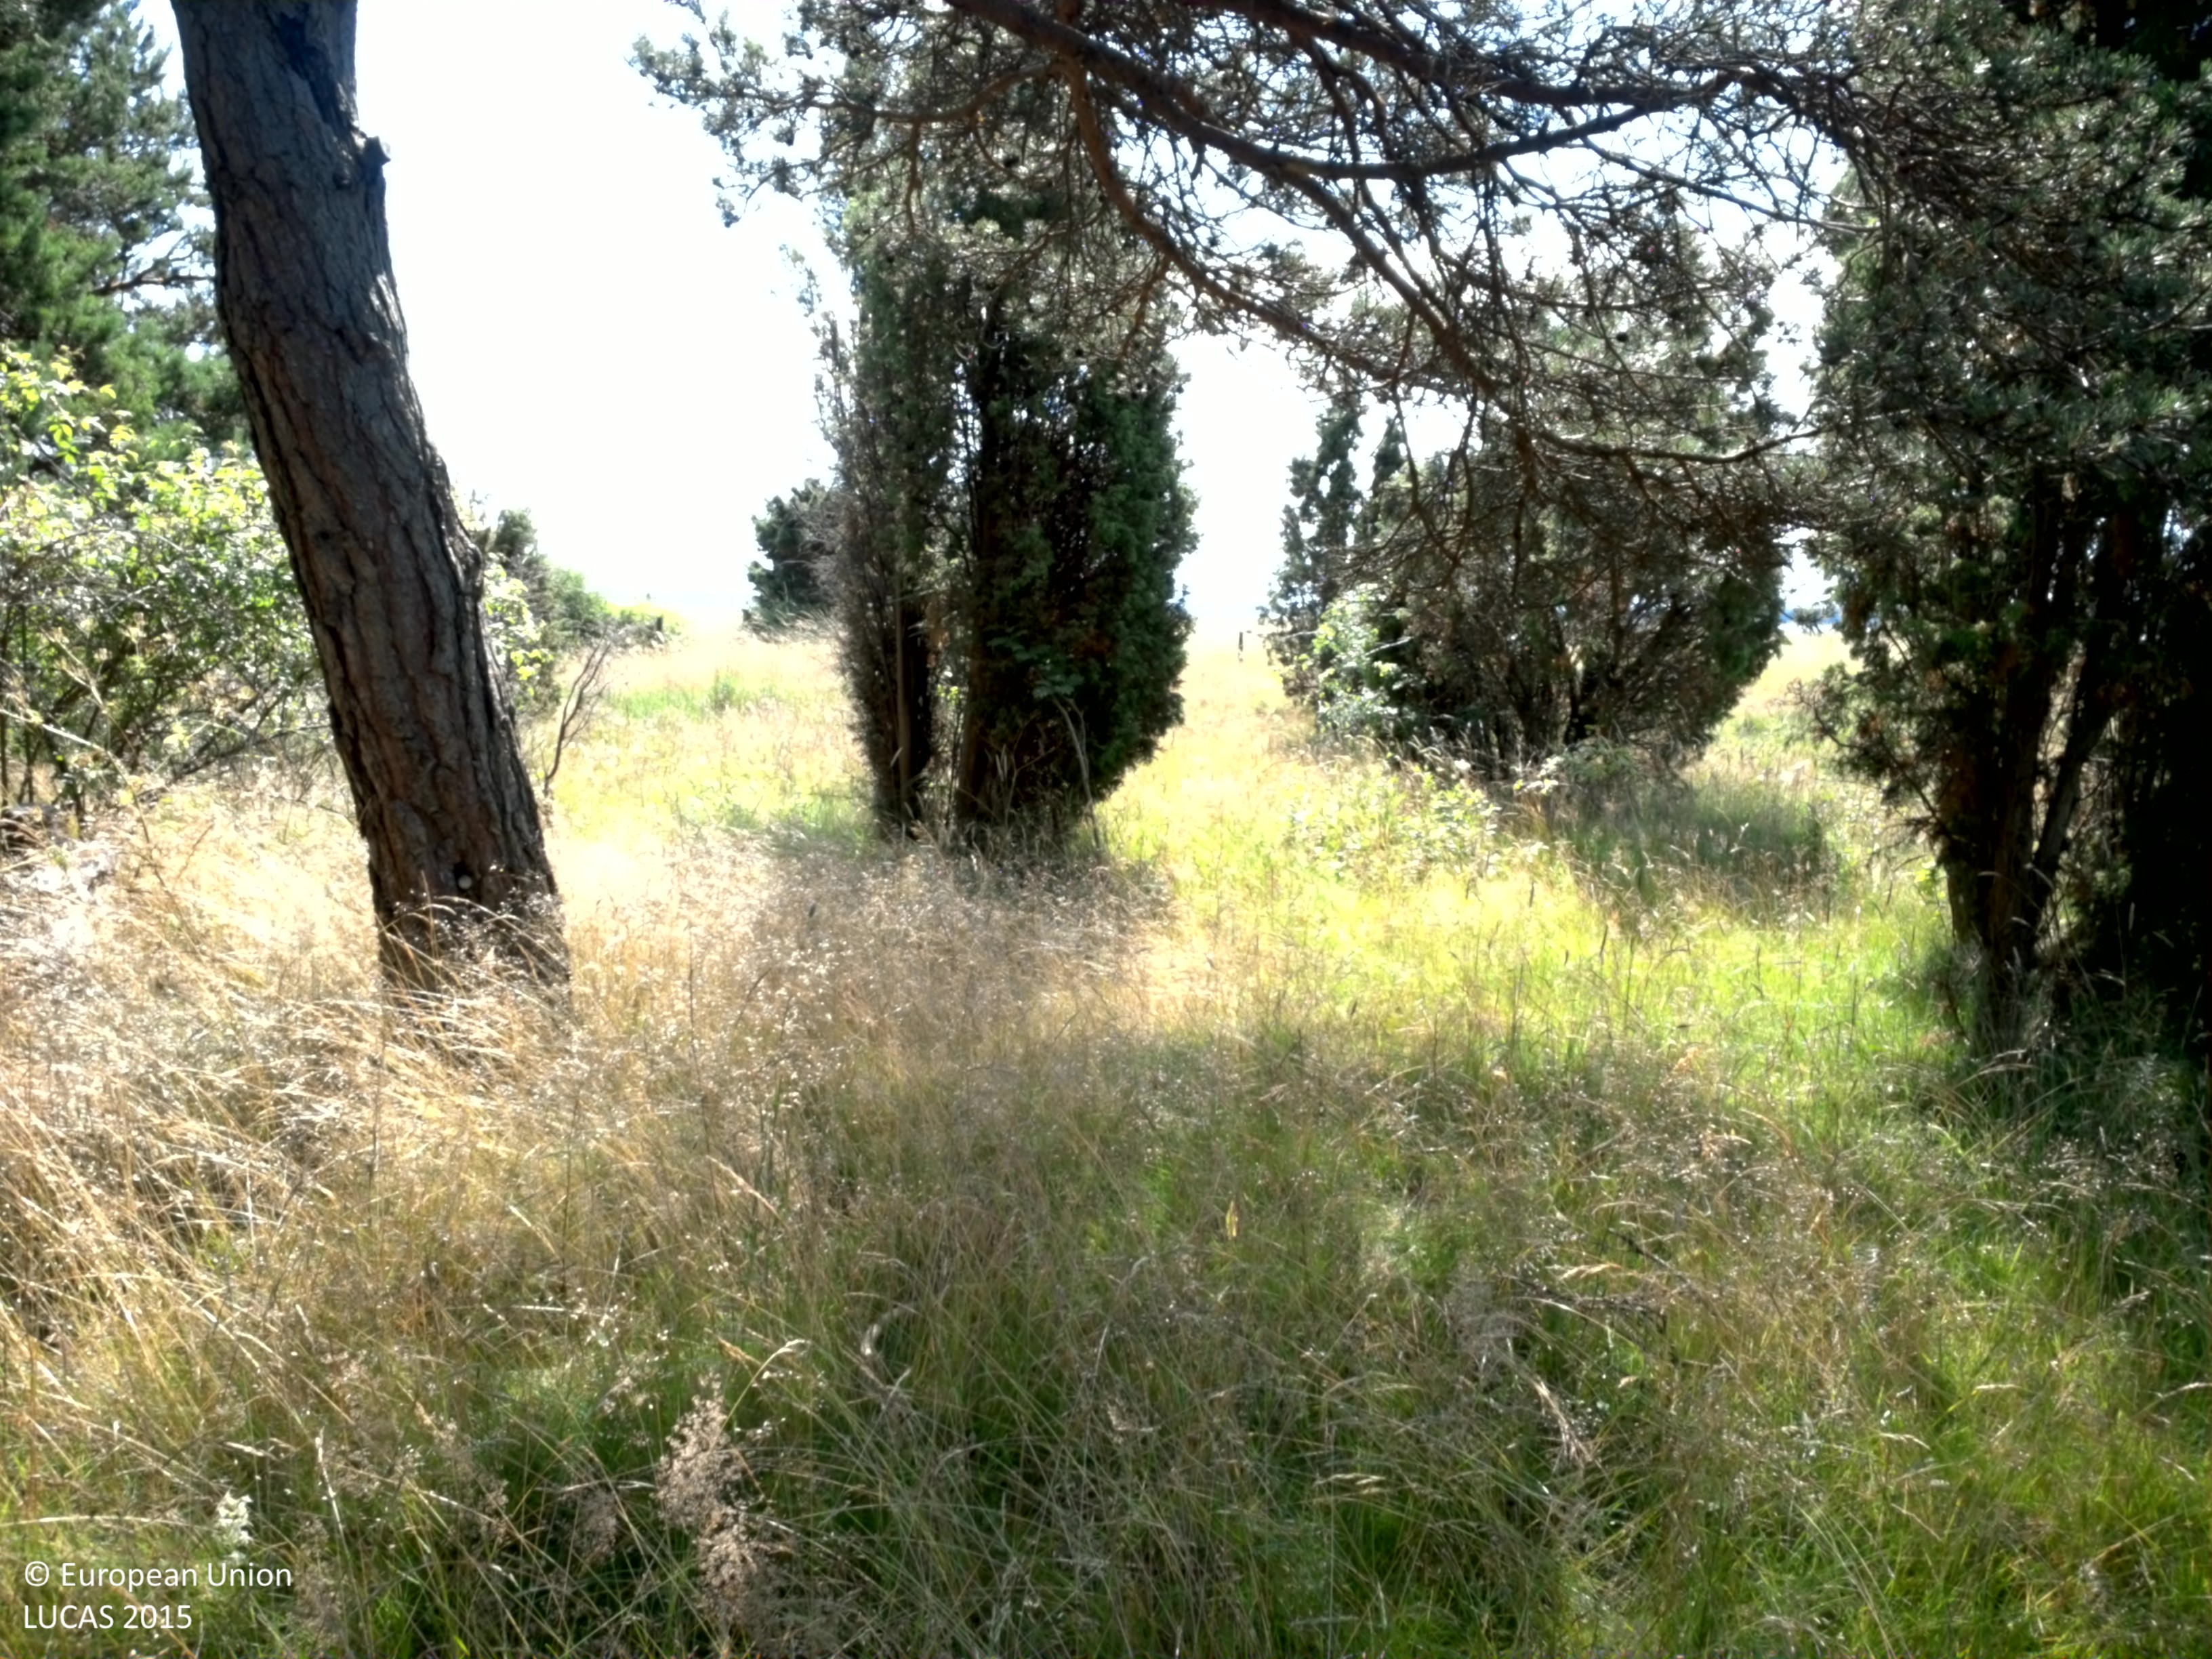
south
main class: Woodland
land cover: Pine dominated coniferous woodland
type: hemiboreal forest and nemoral coniferous forest and mixed broadleaved-coniferous forest
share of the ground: 50 - 75 %
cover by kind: coniferous forest trees 50 %, herbaceous plants 30 %, shrubs 20 %
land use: Amenities, museums, leisure
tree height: > 5 m
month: July
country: SE
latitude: 57.3219
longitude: 18.6958
